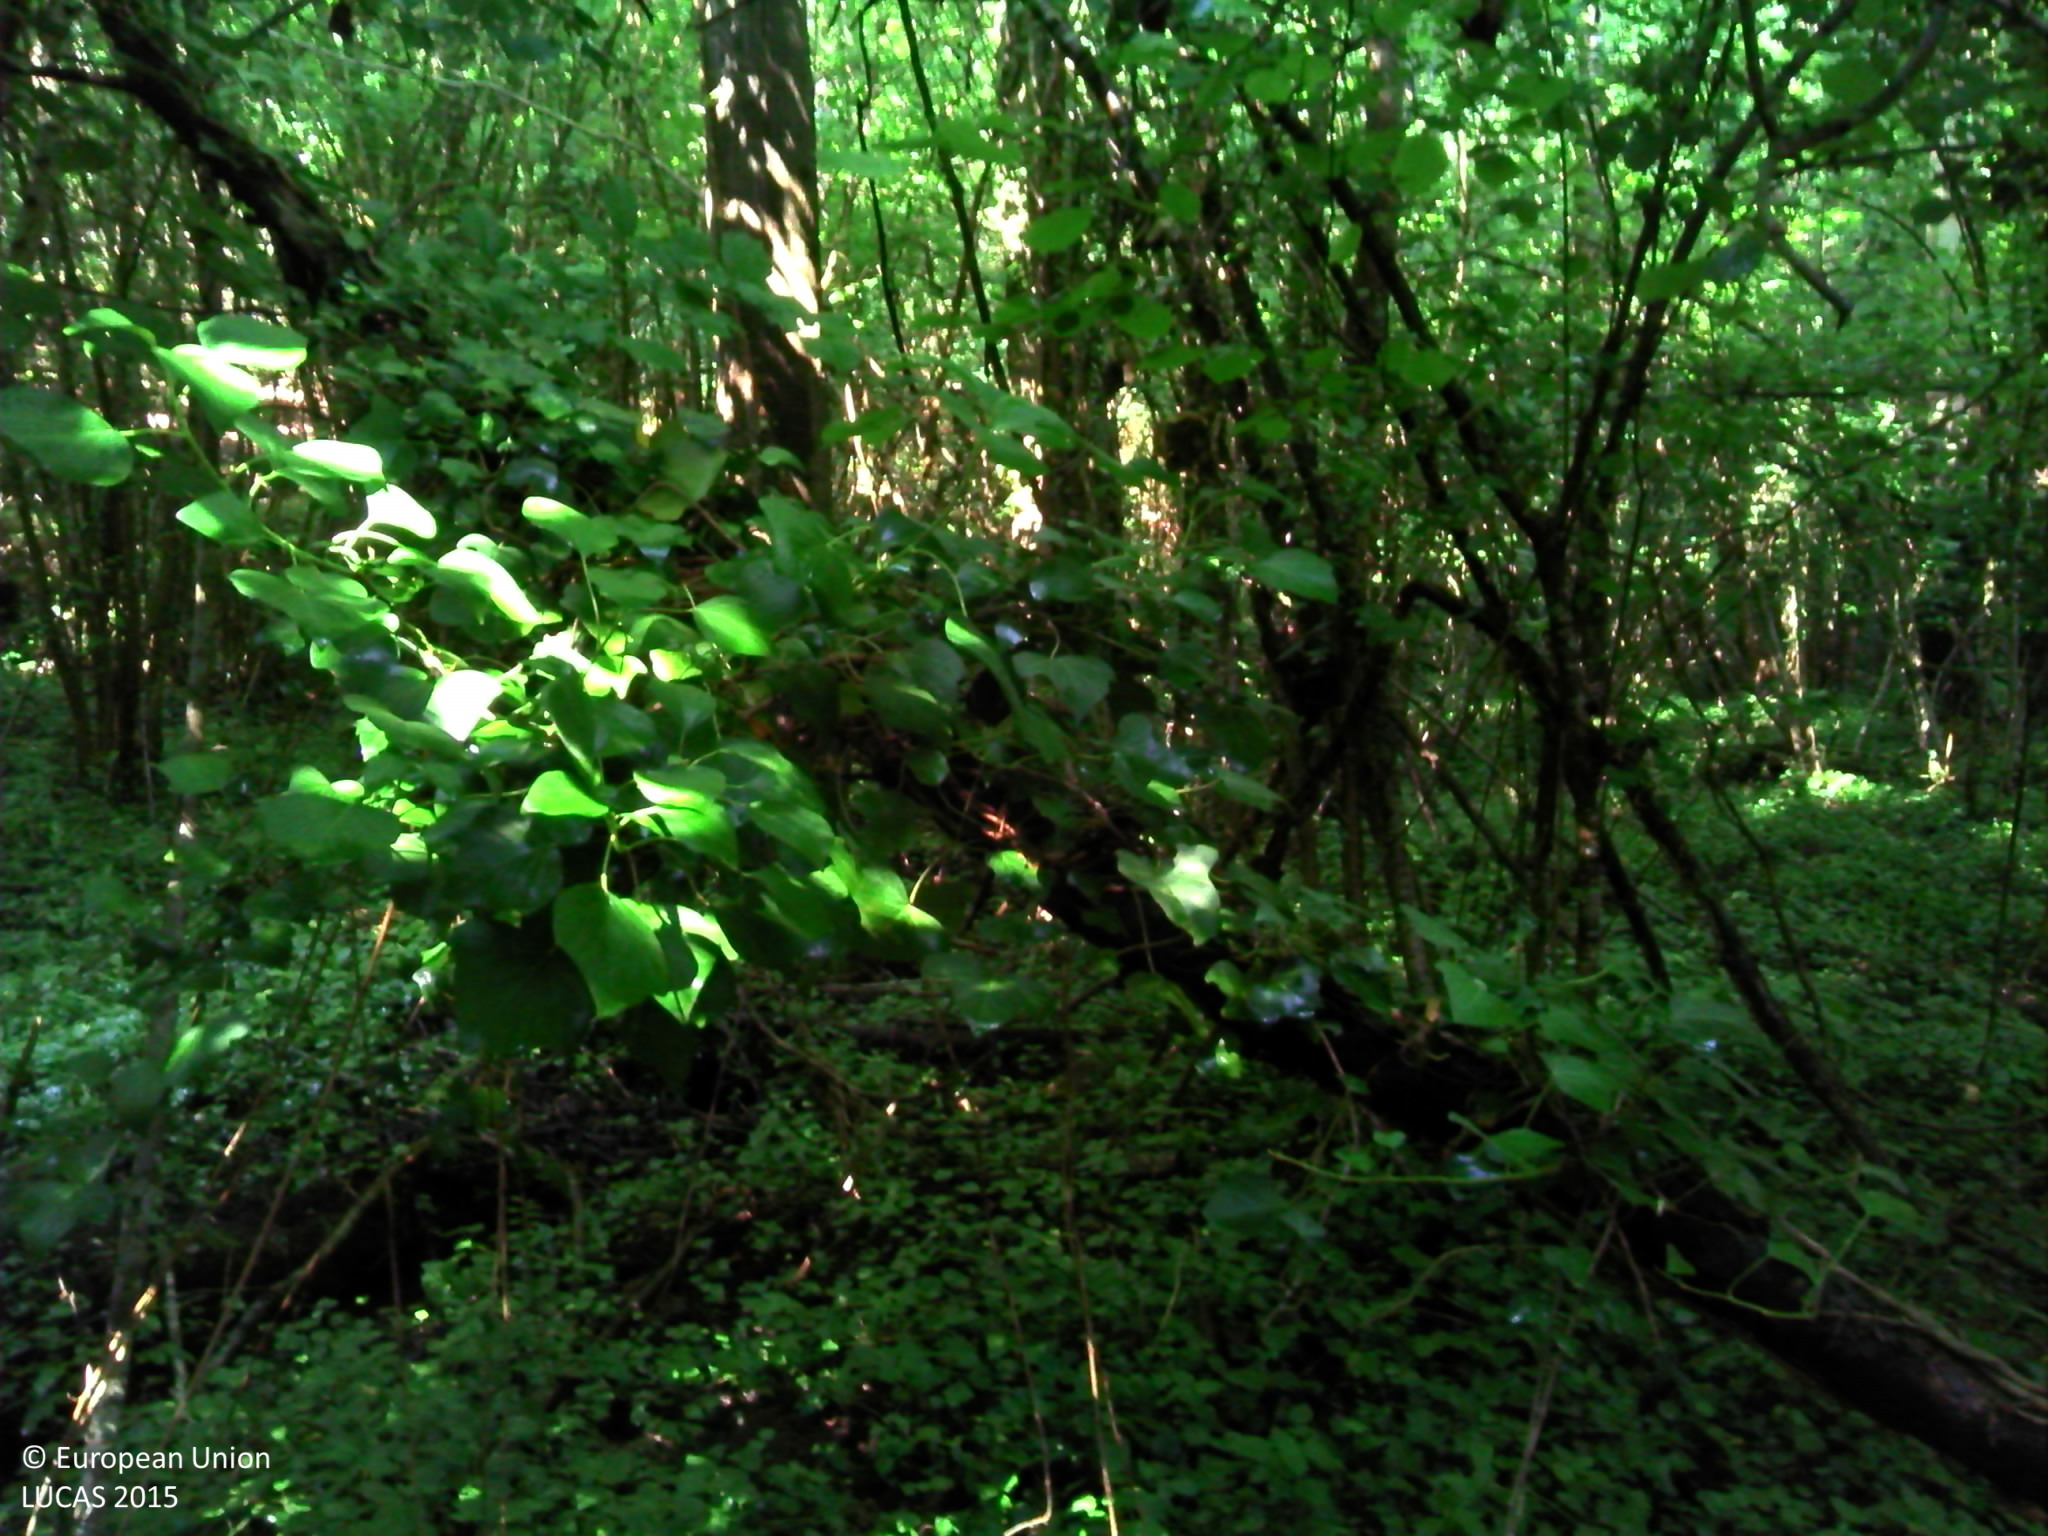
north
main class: Woodland
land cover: Broadleaved woodland
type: mesophytic deciduous forest
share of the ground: > 75 %
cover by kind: herbaceous plants 60 %, broadleaved forest trees 25 %, lichens and mosses 10 %
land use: Forestry
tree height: > 5 m
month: July
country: FR
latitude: 48.2743
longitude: -2.1688
